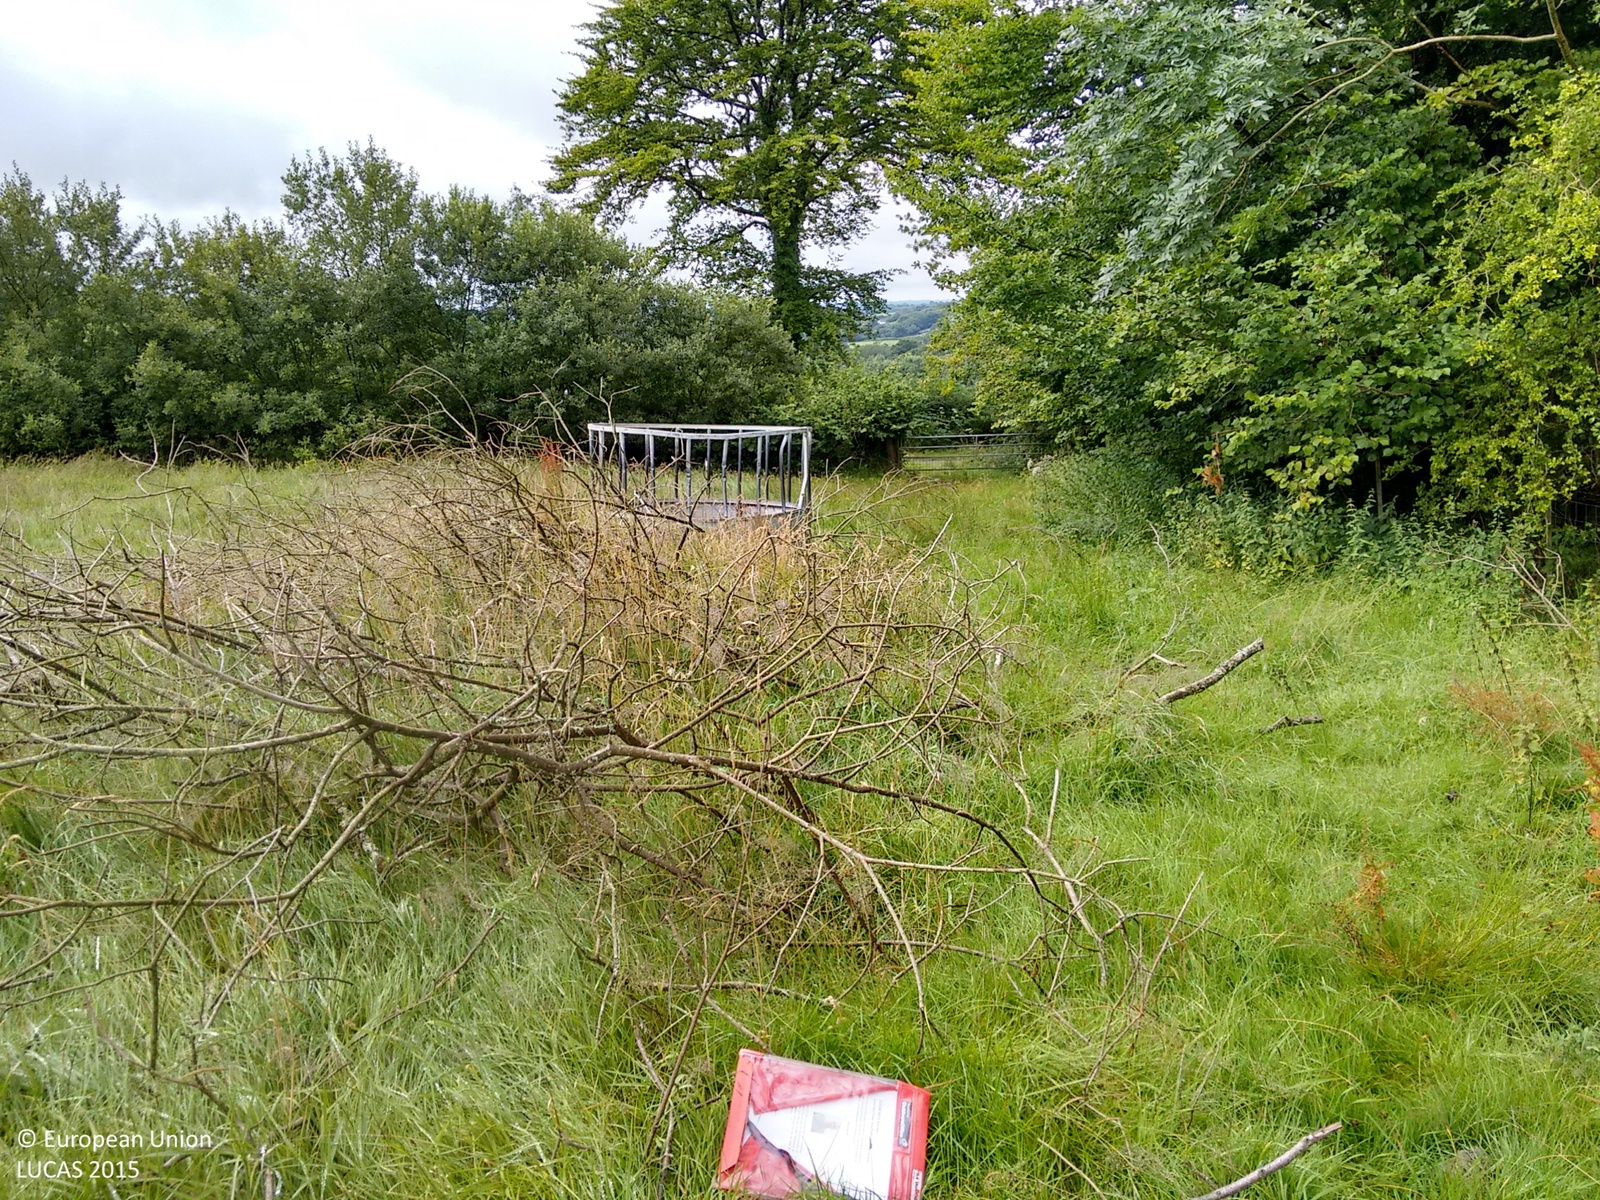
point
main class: Grassland
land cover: Grassland without tree/shrub cover
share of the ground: > 75 %
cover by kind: herbaceous plants 100 %
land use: Agriculture (excluding fallow land and kitchen gardens)
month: August
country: GB
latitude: 51.9175
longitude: -4.0681
